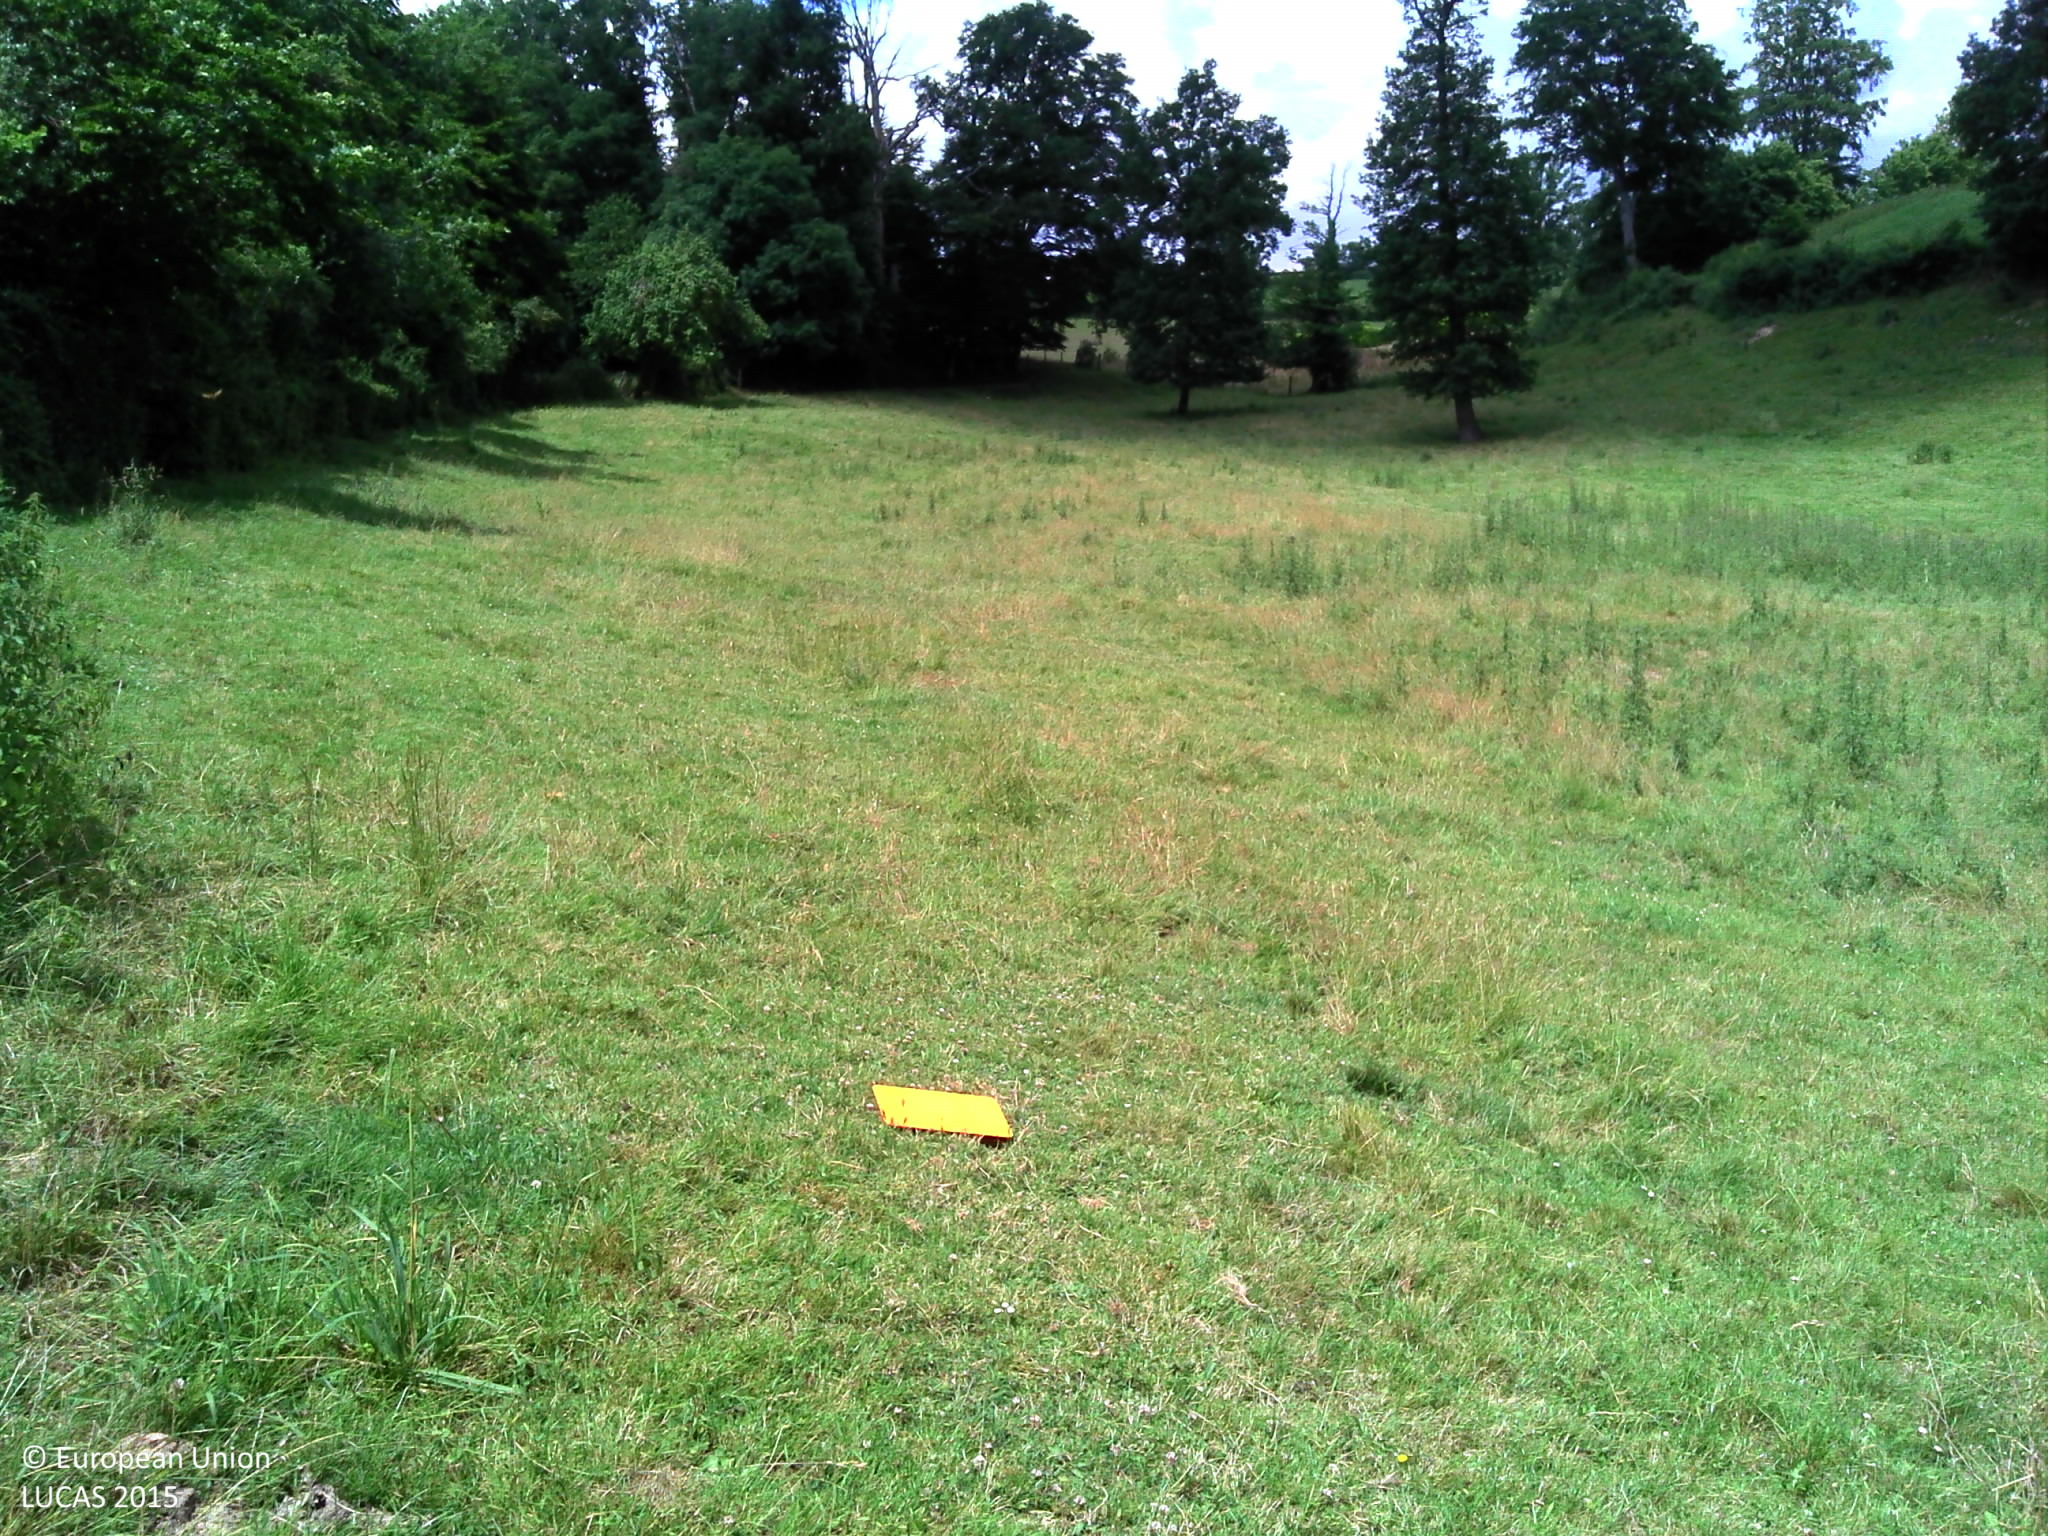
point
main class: Grassland
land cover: Grassland without tree/shrub cover
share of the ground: > 75 %
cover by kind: herbaceous plants 100 %
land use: Agriculture (excluding fallow land and kitchen gardens)
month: June
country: FR
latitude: 44.2780
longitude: 2.4983
